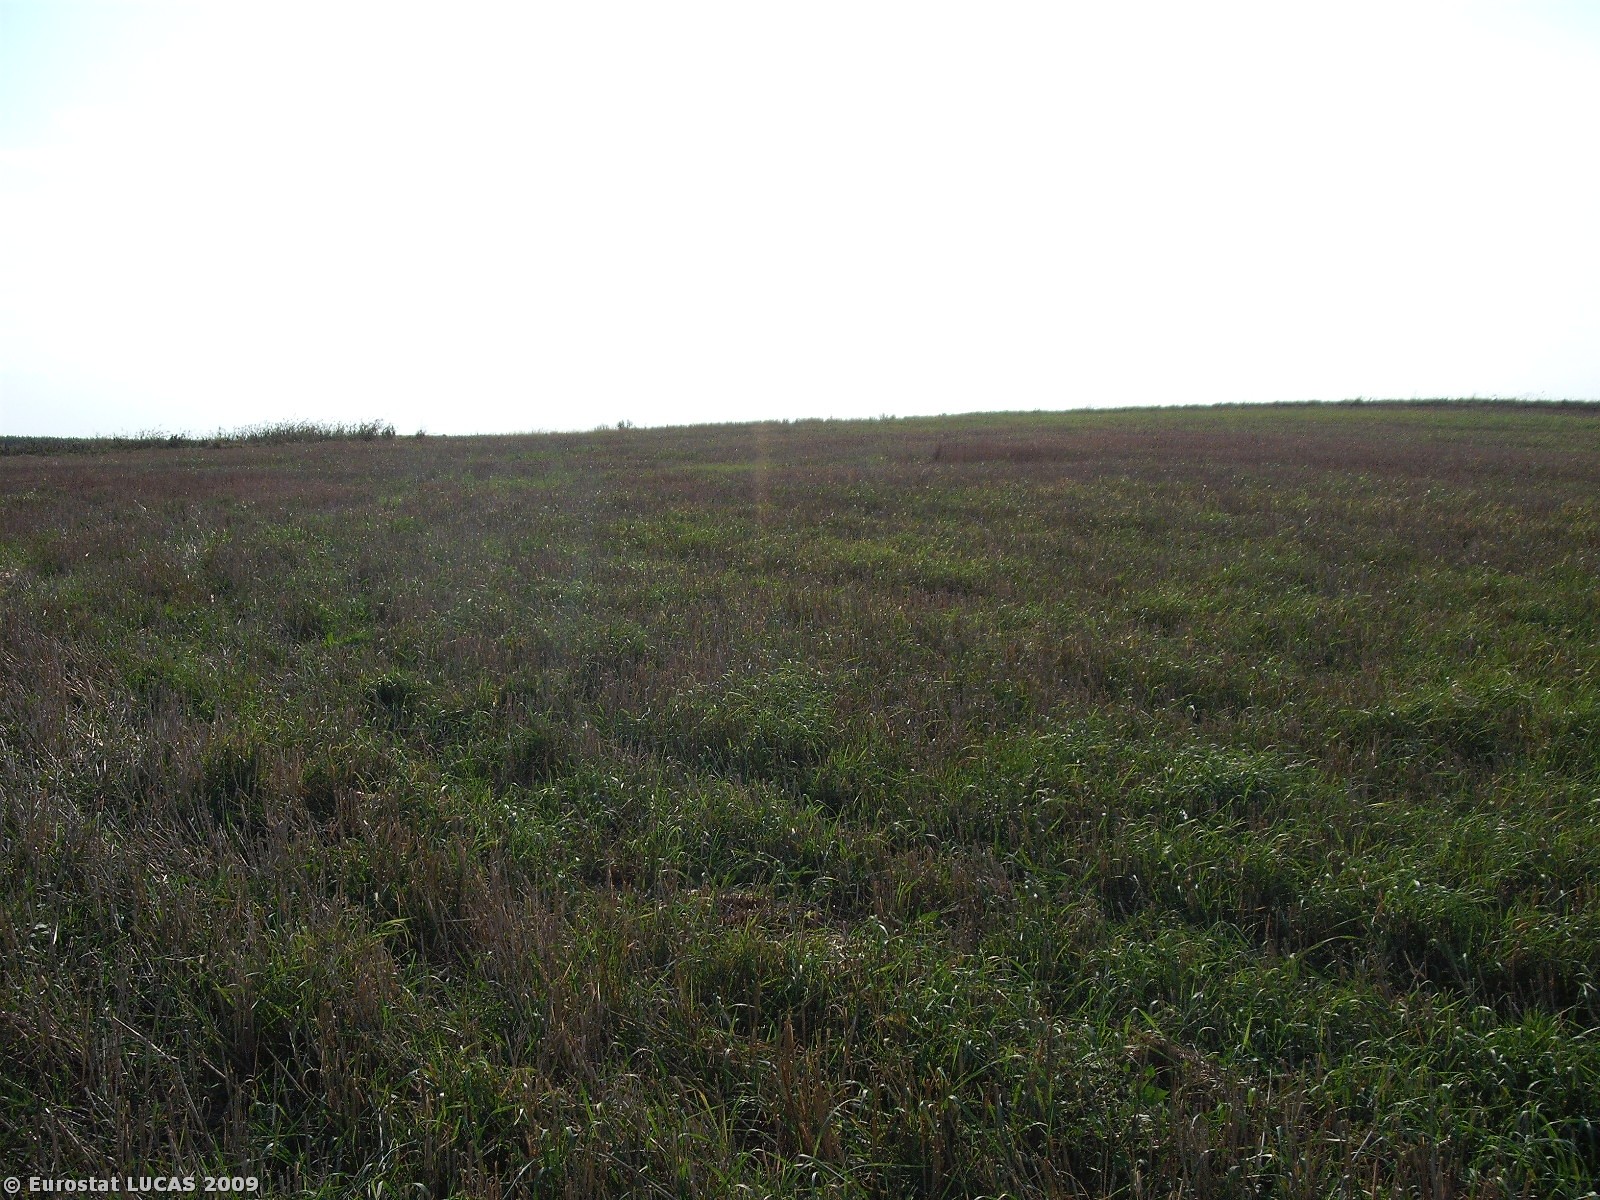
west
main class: Cropland
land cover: Common wheat
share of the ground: < 10 %
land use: Agriculture (excluding fallow land and kitchen gardens)
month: August
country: PL
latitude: 49.9561
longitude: 22.4273
